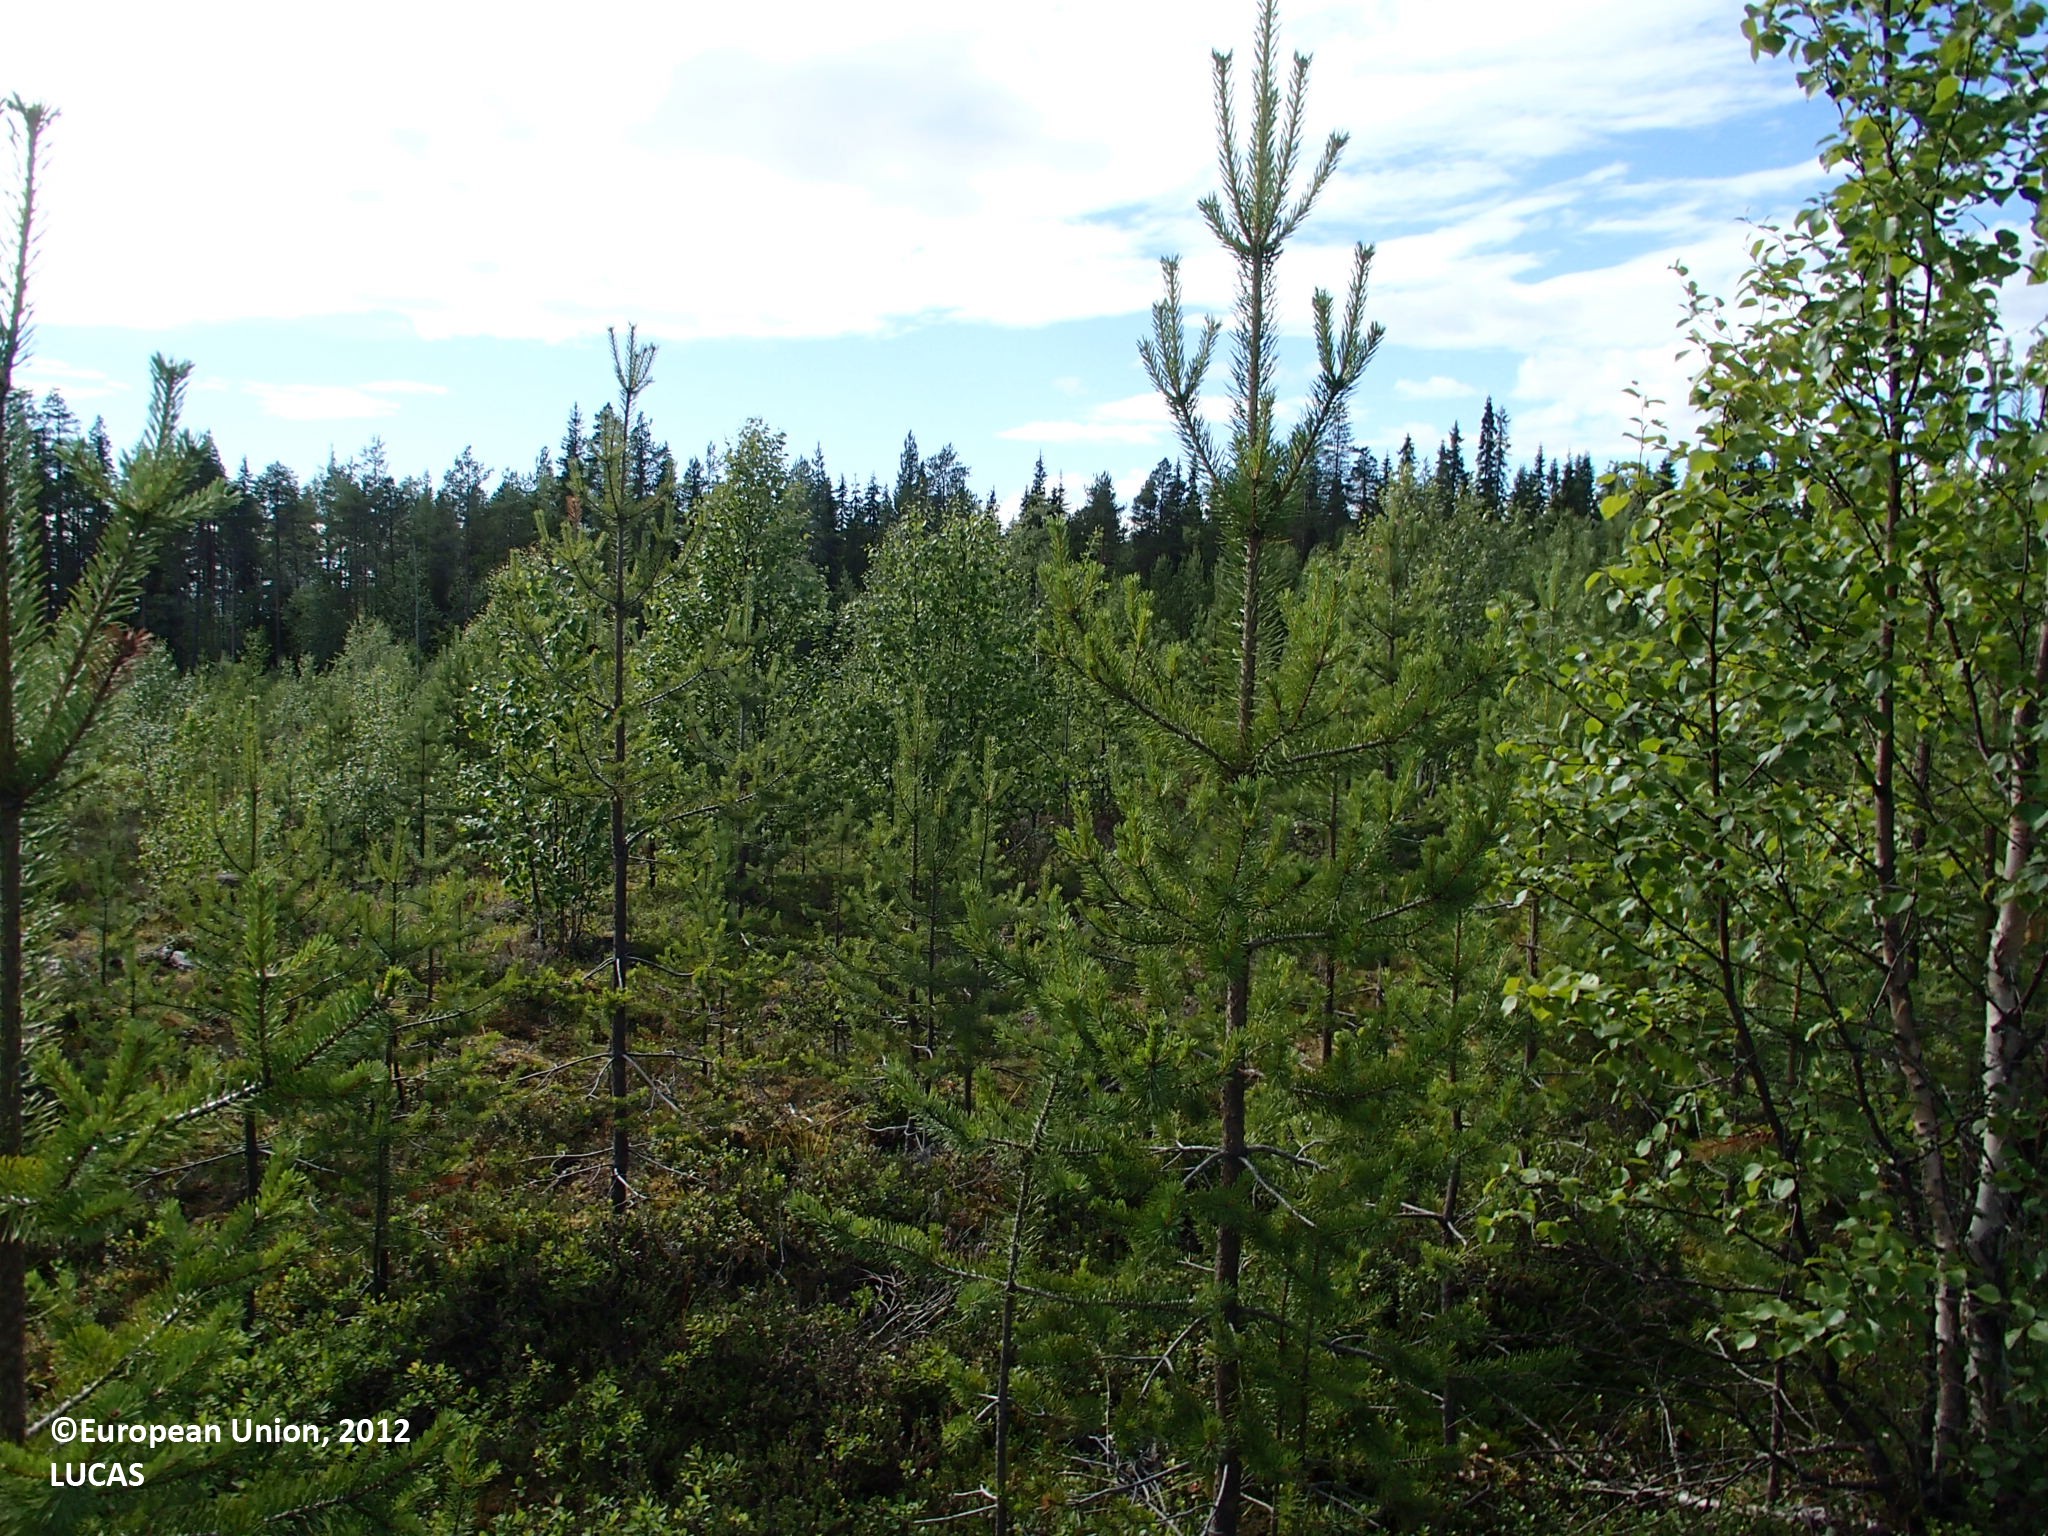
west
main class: Woodland
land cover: Other mixed woodland
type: boreal forest
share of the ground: 25 - 50 %
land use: Forestry
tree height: < 5 m
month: July
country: FI
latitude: 66.6417
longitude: 25.3608
